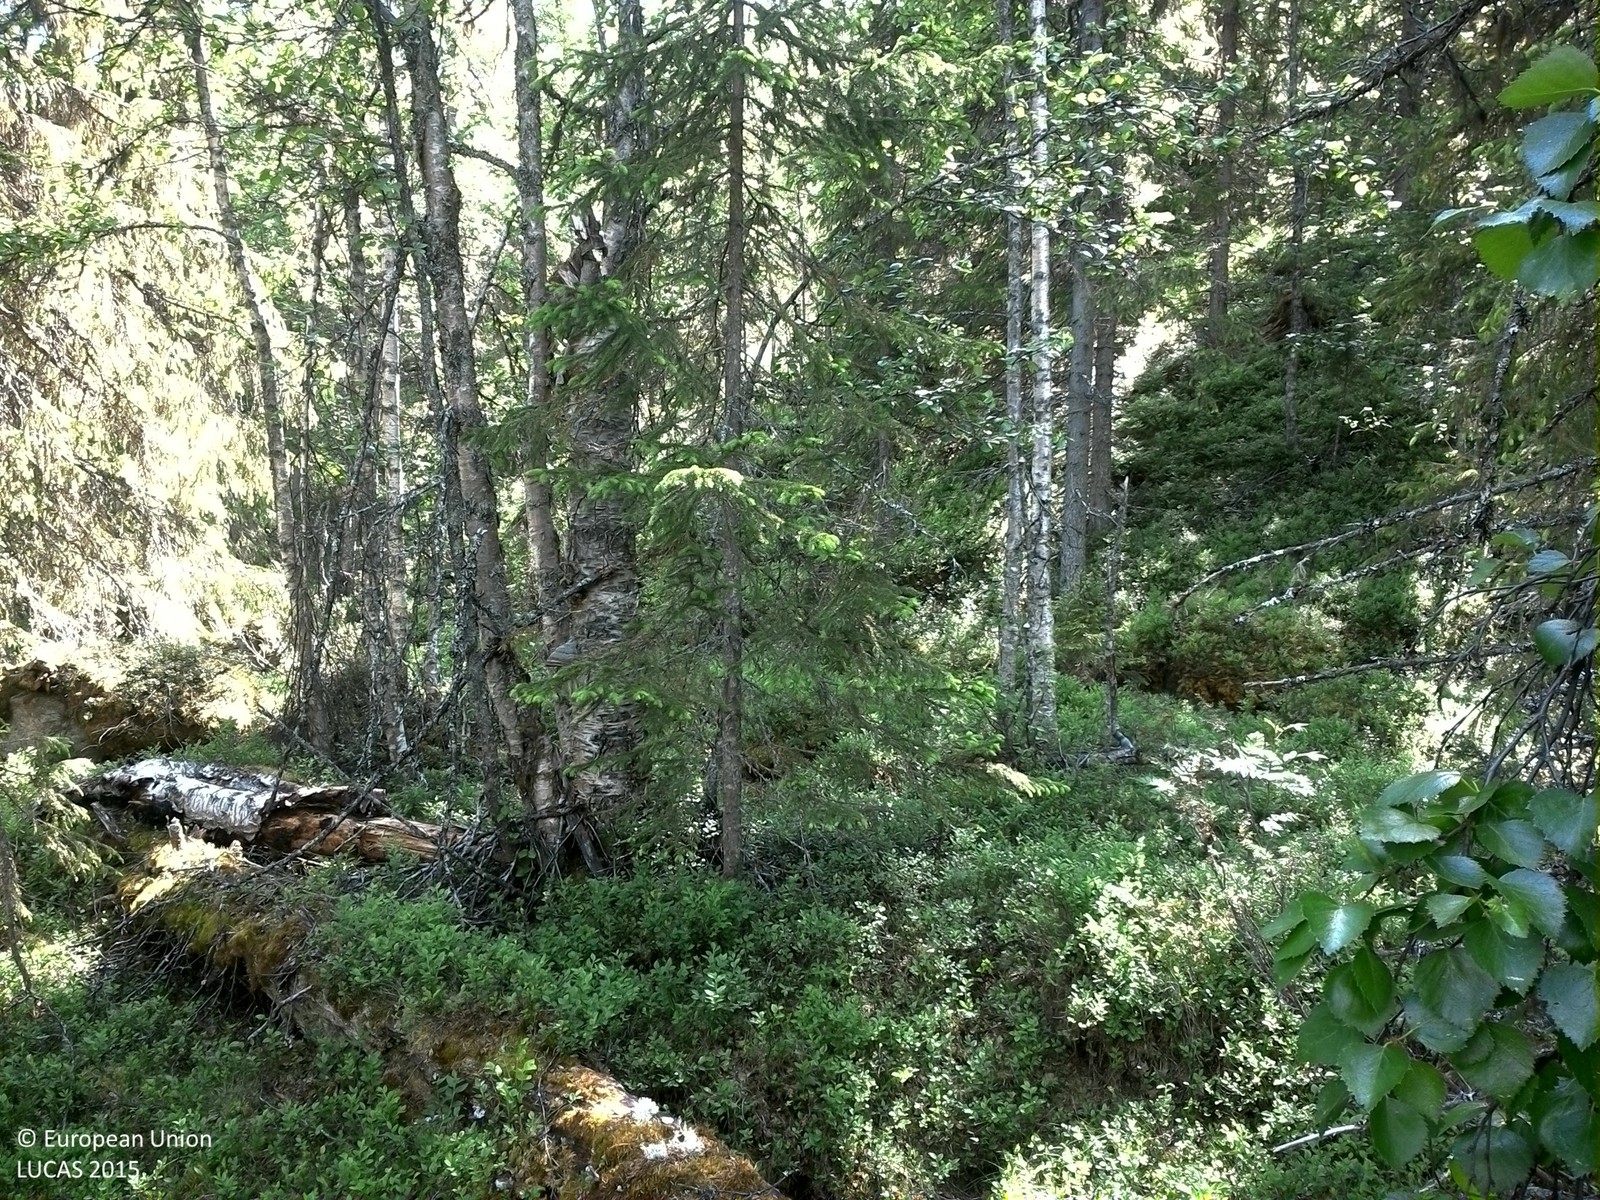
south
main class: Woodland
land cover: Spruce dominated coniferous woodland
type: boreal forest
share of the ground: 50 - 75 %
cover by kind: coniferous forest trees 50 %, shrubs 35 %, herbaceous plants 10 %, broadleaved forest trees 5 %
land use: Forestry
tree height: > 5 m
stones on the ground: 25 - 50 %
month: July
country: SE
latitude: 64.4245
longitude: 16.1350
